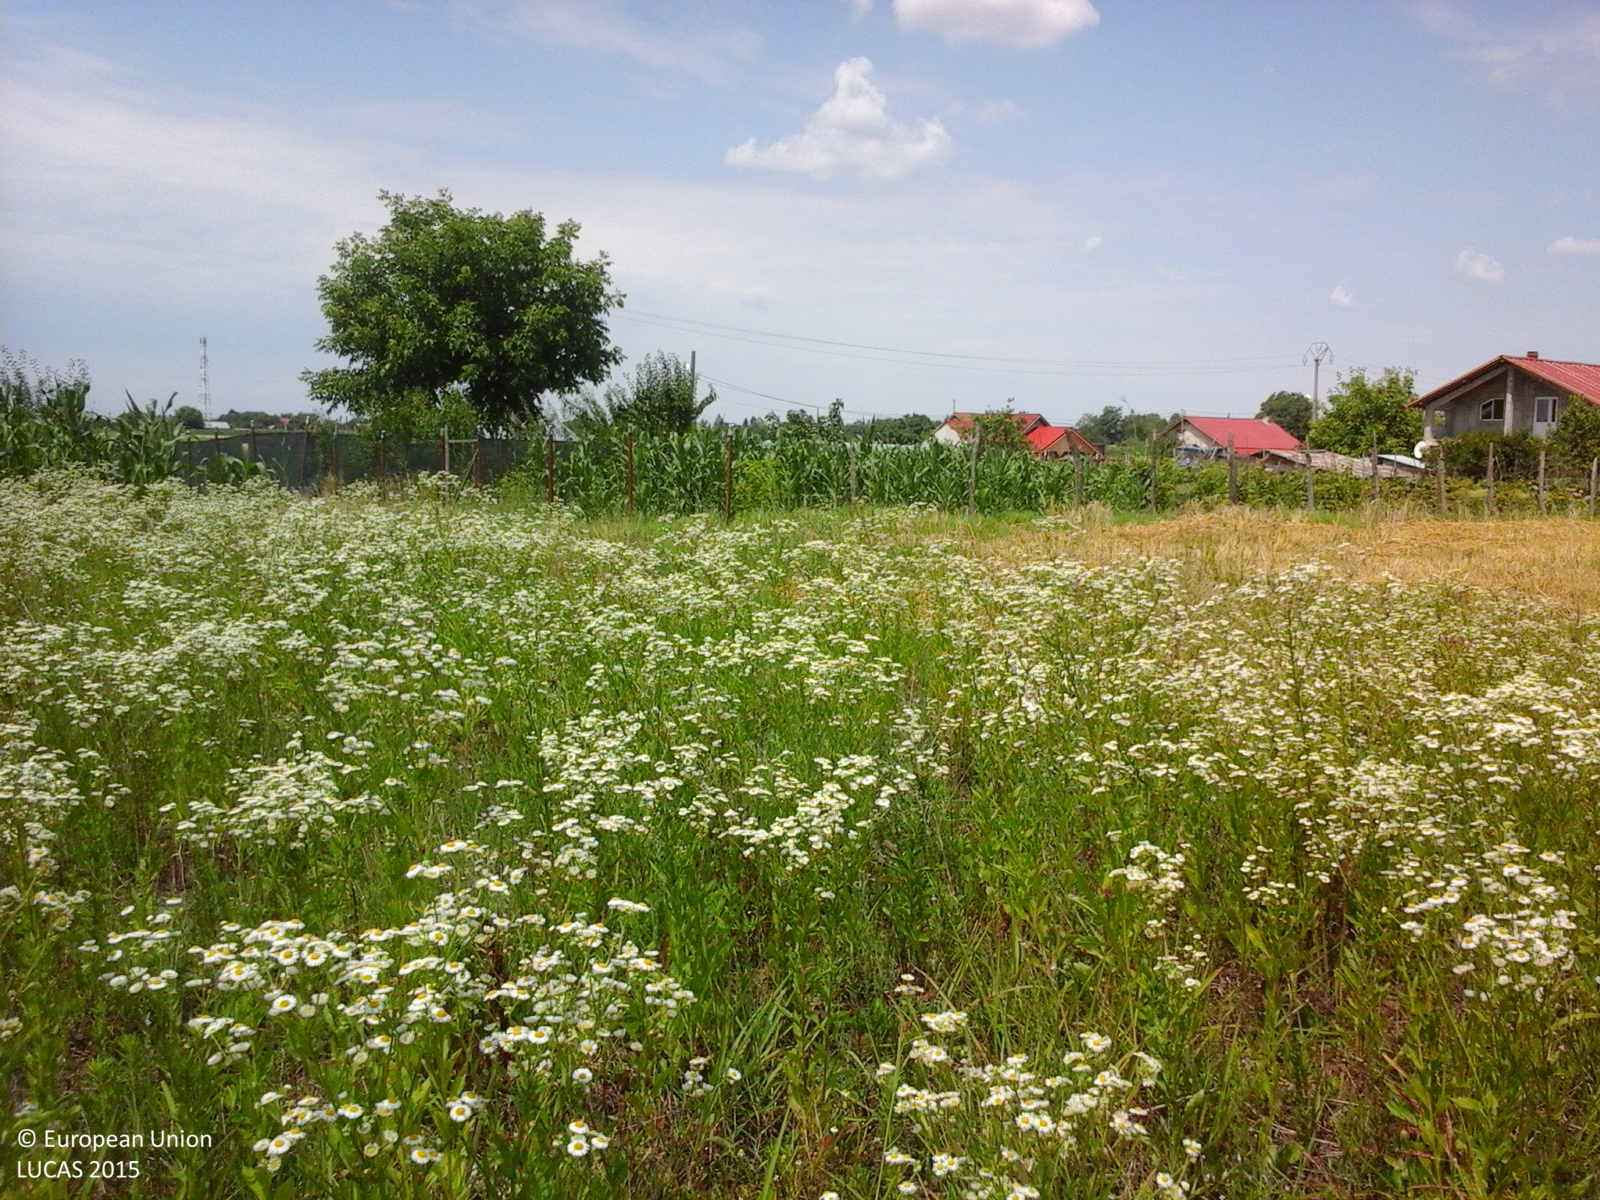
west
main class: Grassland
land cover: Spontaneously vegetated surfaces
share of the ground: > 75 %
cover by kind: herbaceous plants 100 %
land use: Agriculture (excluding fallow land and kitchen gardens)
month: June
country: RO
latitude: 44.6412
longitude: 26.2354
